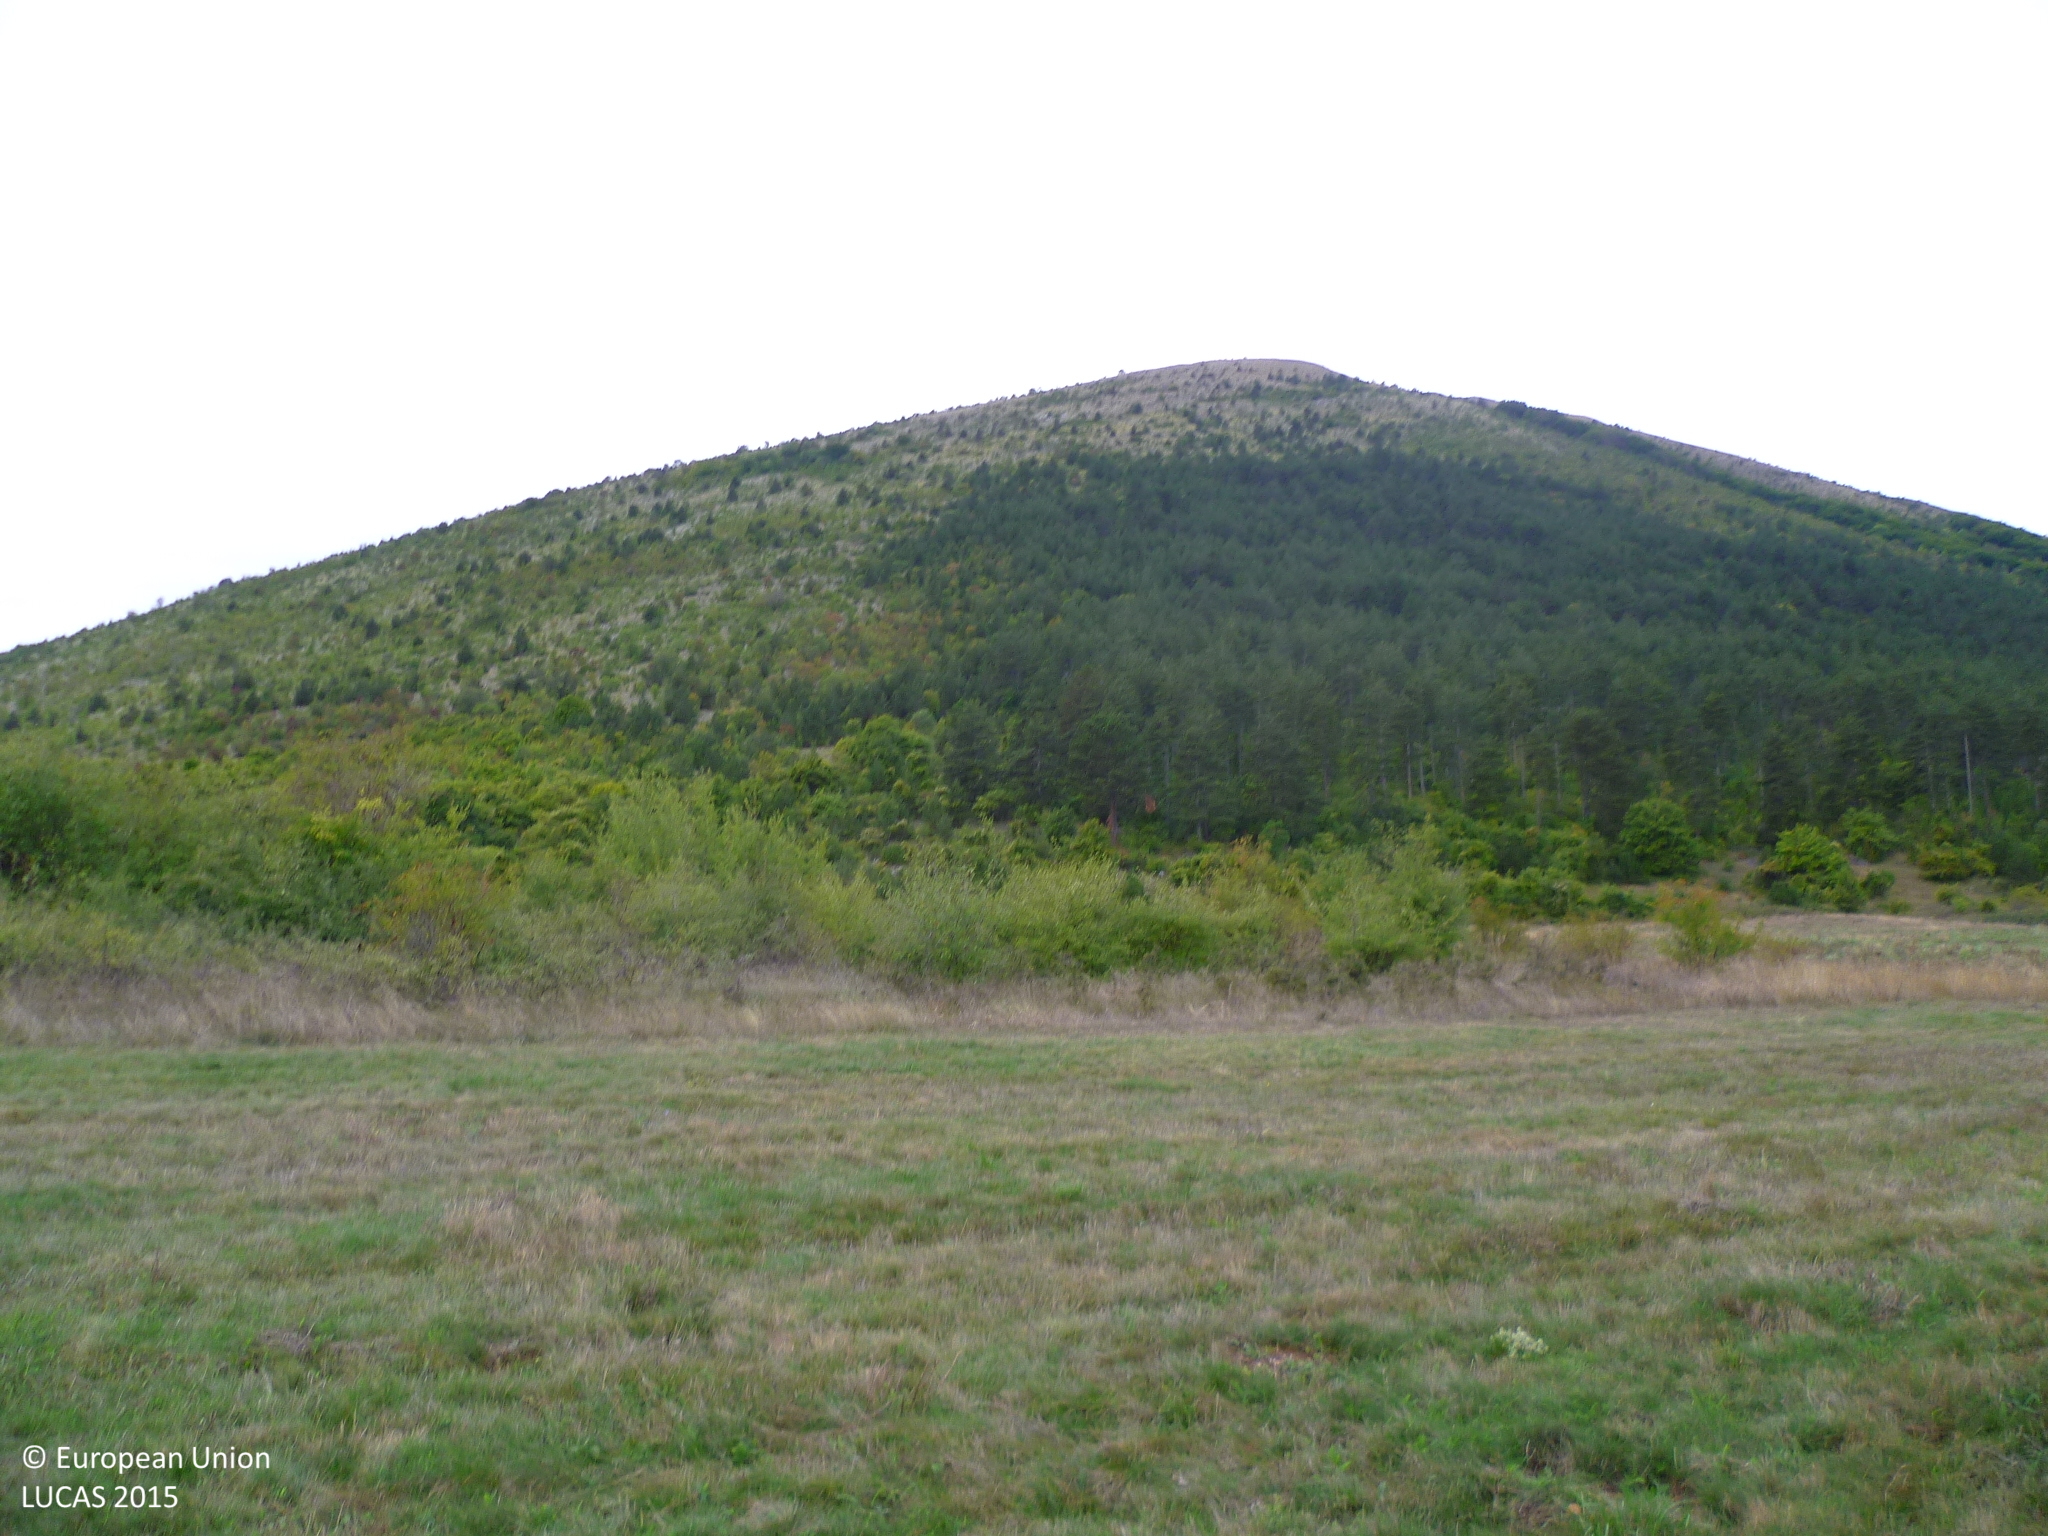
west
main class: Grassland
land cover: Grassland without tree/shrub cover
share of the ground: > 75 %
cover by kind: herbaceous plants 100 %
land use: Agriculture (excluding fallow land and kitchen gardens)
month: September
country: BG
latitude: 42.7549
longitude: 22.7709
